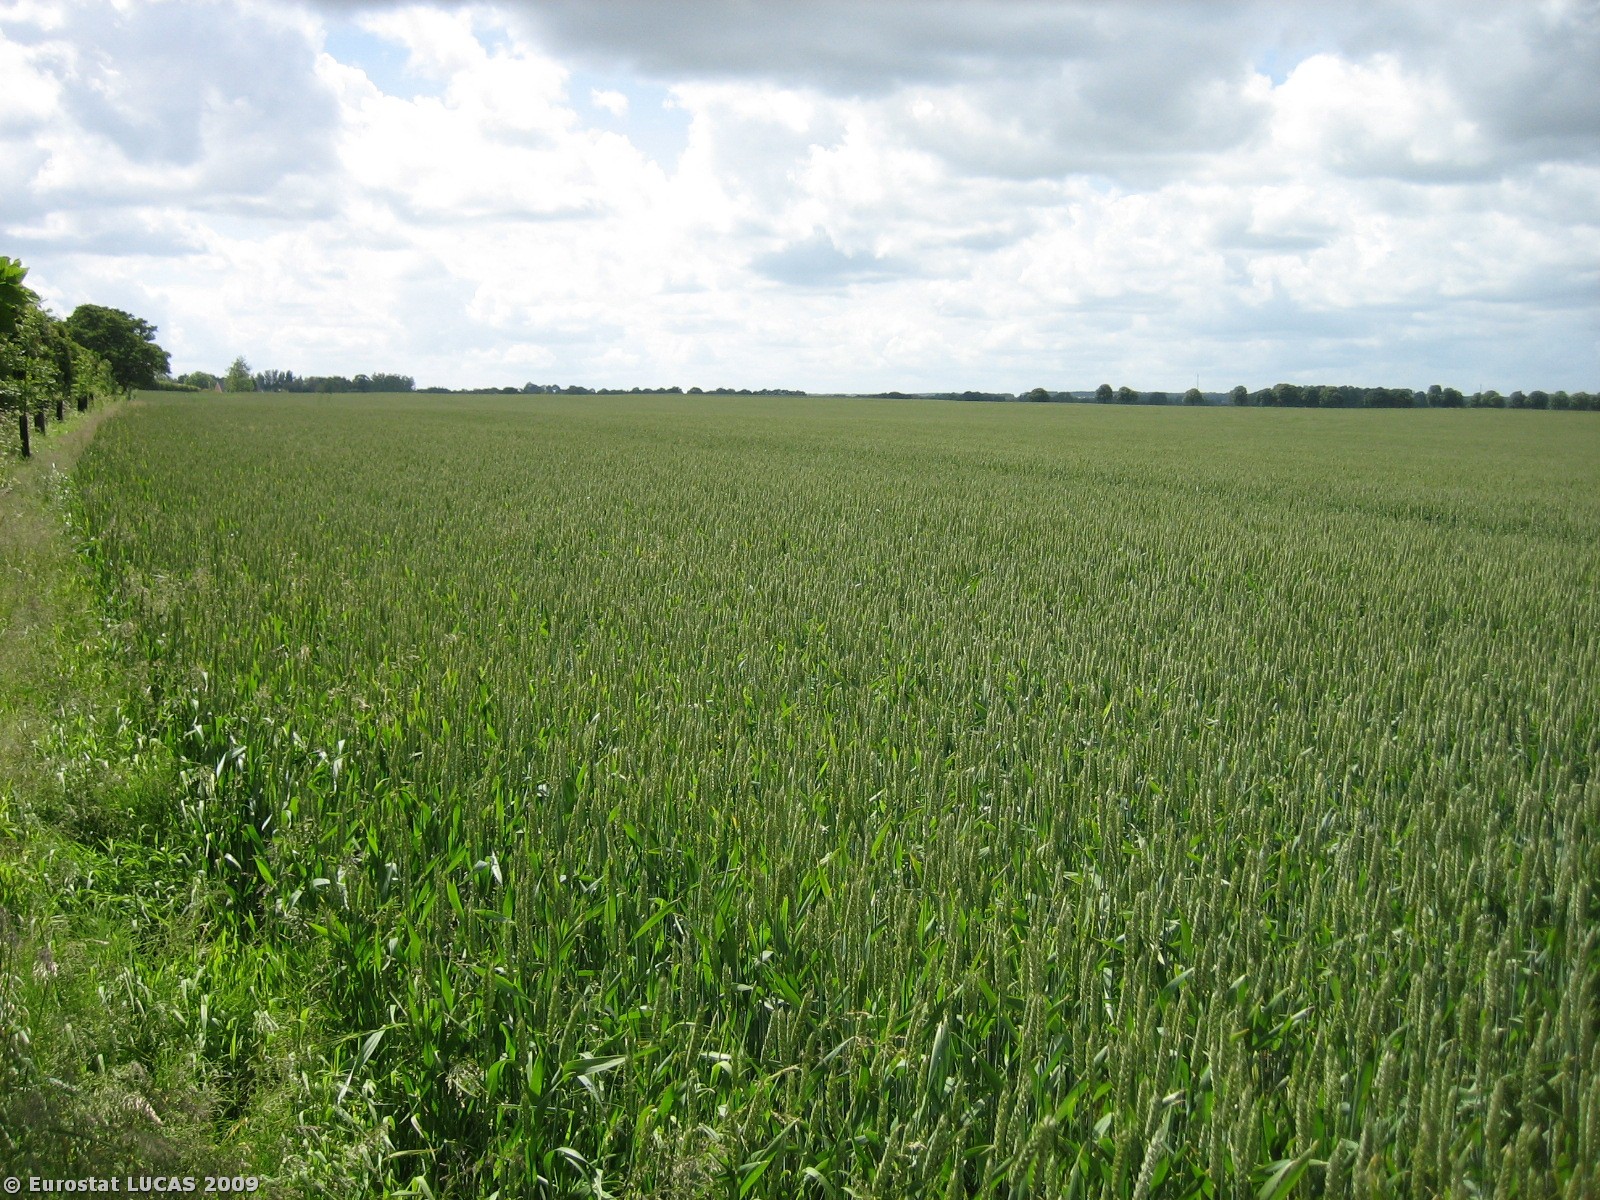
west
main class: Cropland
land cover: Common wheat
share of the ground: > 75 %
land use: Agriculture (excluding fallow land and kitchen gardens)
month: June
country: DK
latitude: 55.5942
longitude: 9.6988
